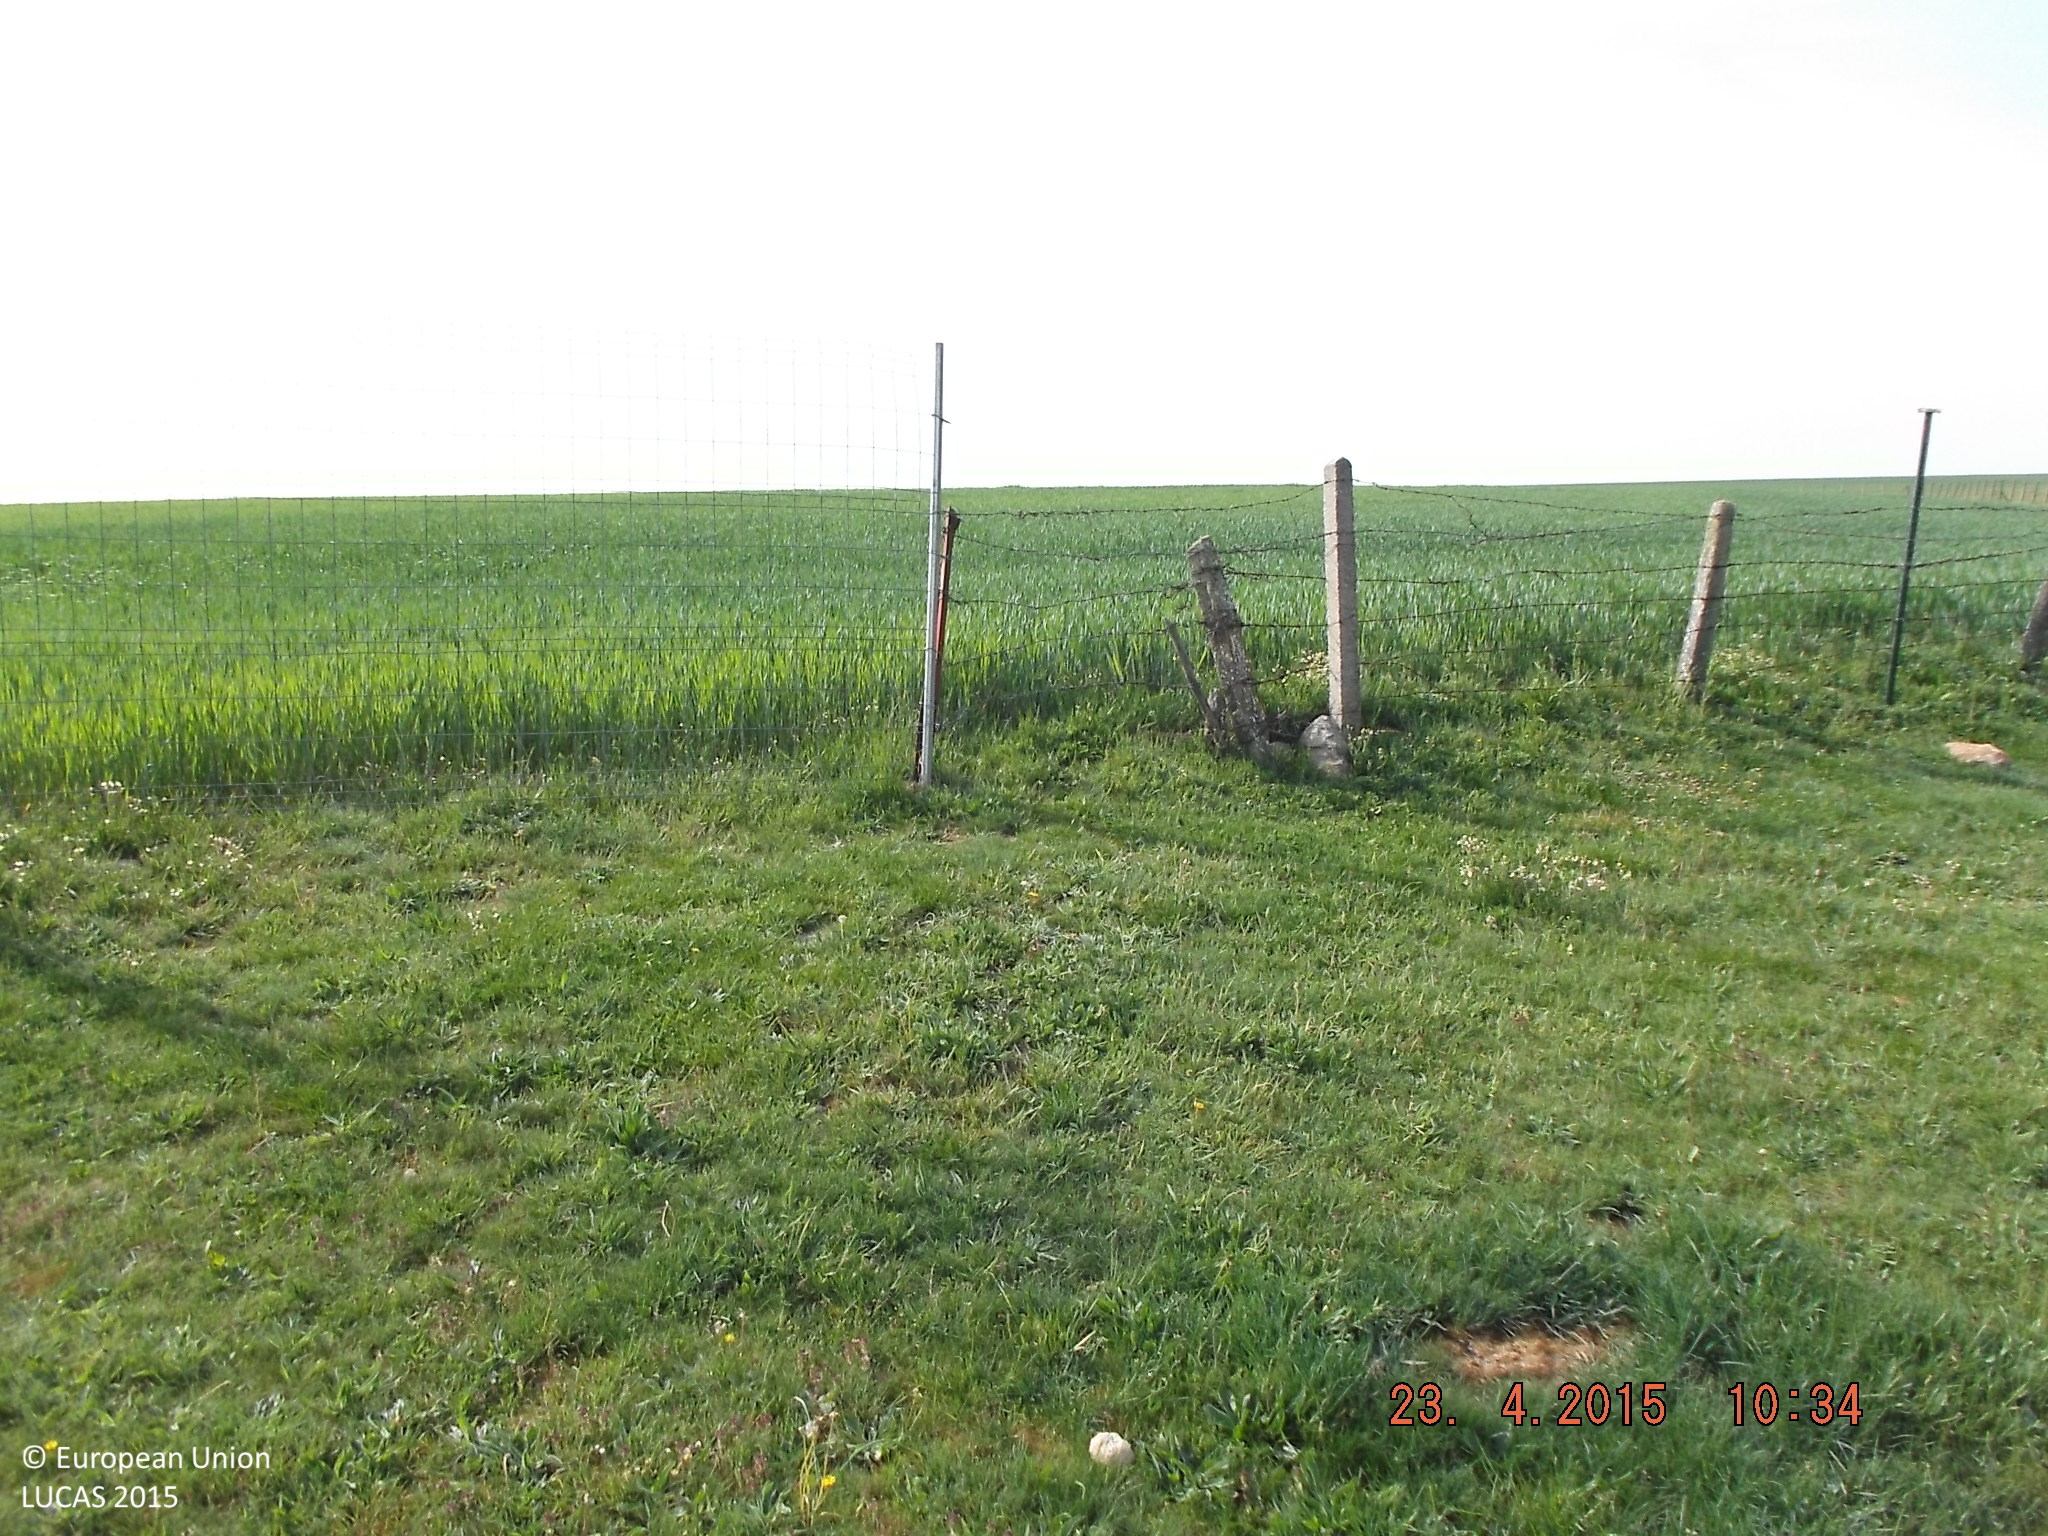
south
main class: Grassland
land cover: Grassland without tree/shrub cover
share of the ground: > 75 %
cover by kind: herbaceous plants 100 %
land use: Agriculture (excluding fallow land and kitchen gardens)
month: April
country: ES
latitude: 40.9450
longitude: -5.9162
